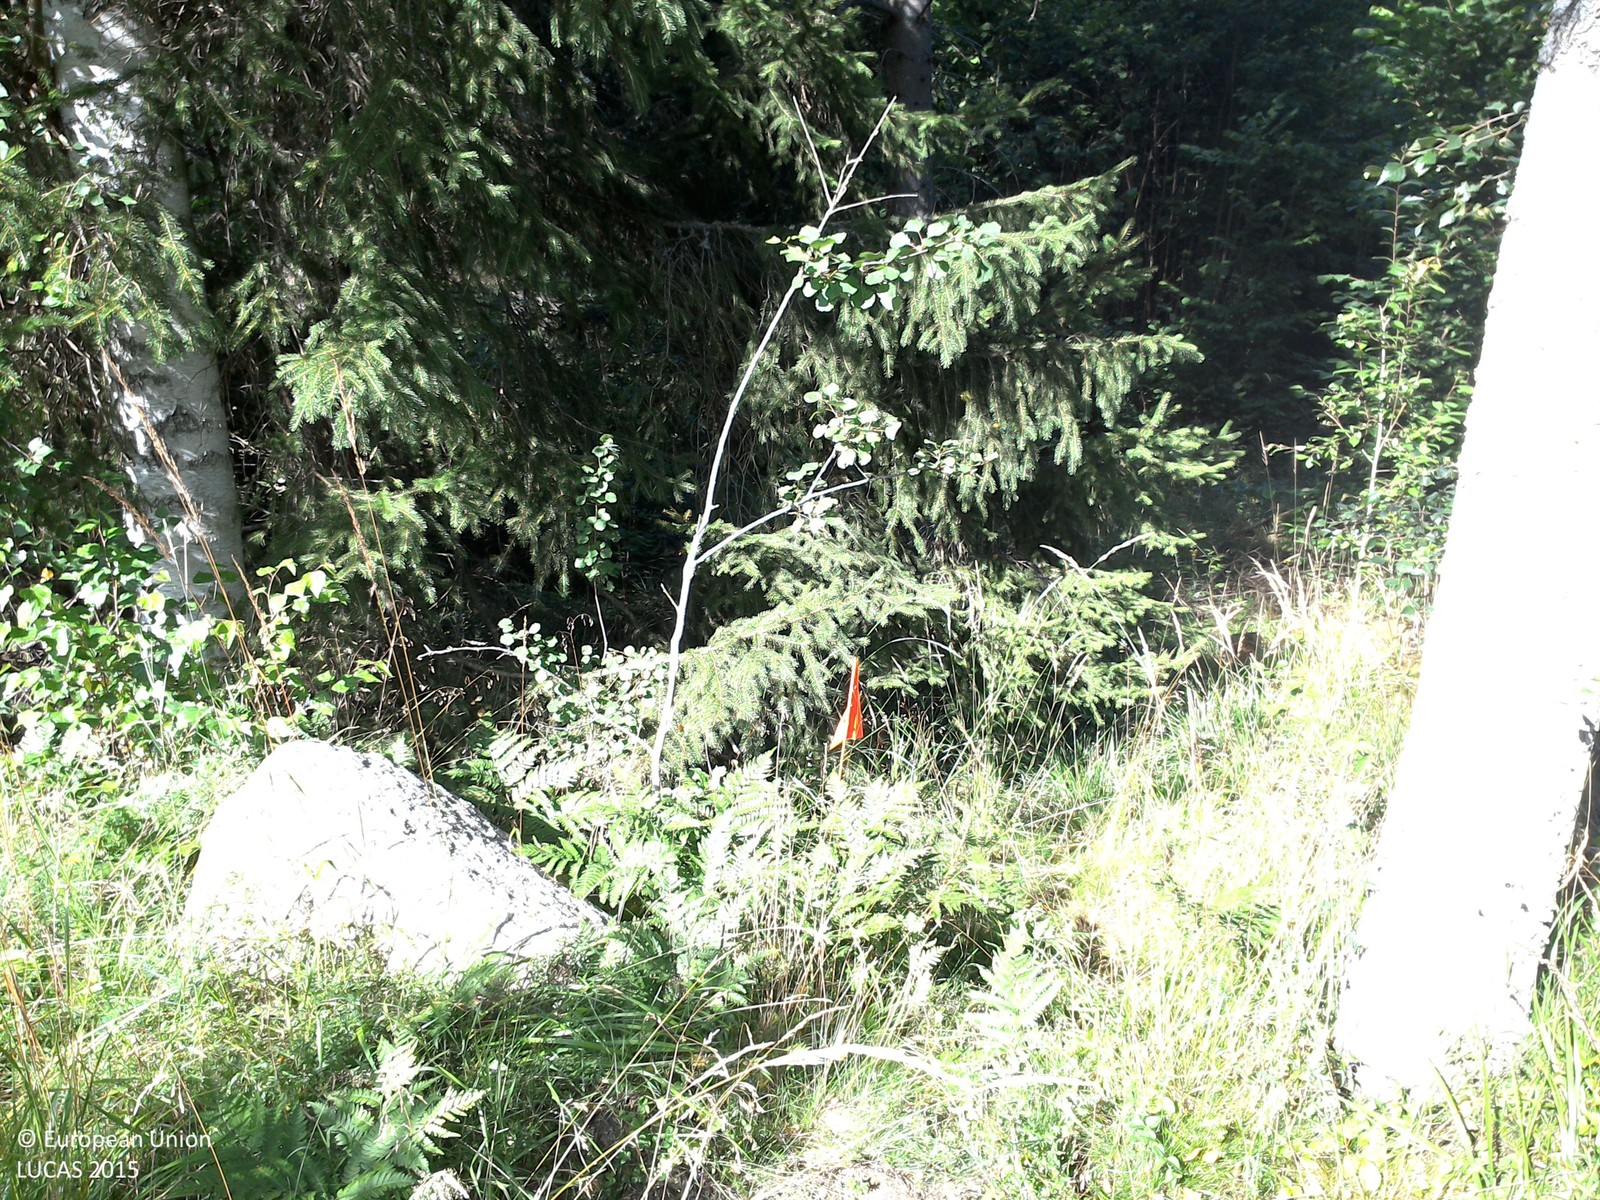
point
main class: Woodland
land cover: Broadleaved woodland
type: boreal forest
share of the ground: 50 - 75 %
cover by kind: broadleaved forest trees 55 %, herbaceous plants 40 %, coniferous forest trees 5 %
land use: Forestry
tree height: > 5 m
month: August
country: SE
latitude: 57.9604
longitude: 15.5560
